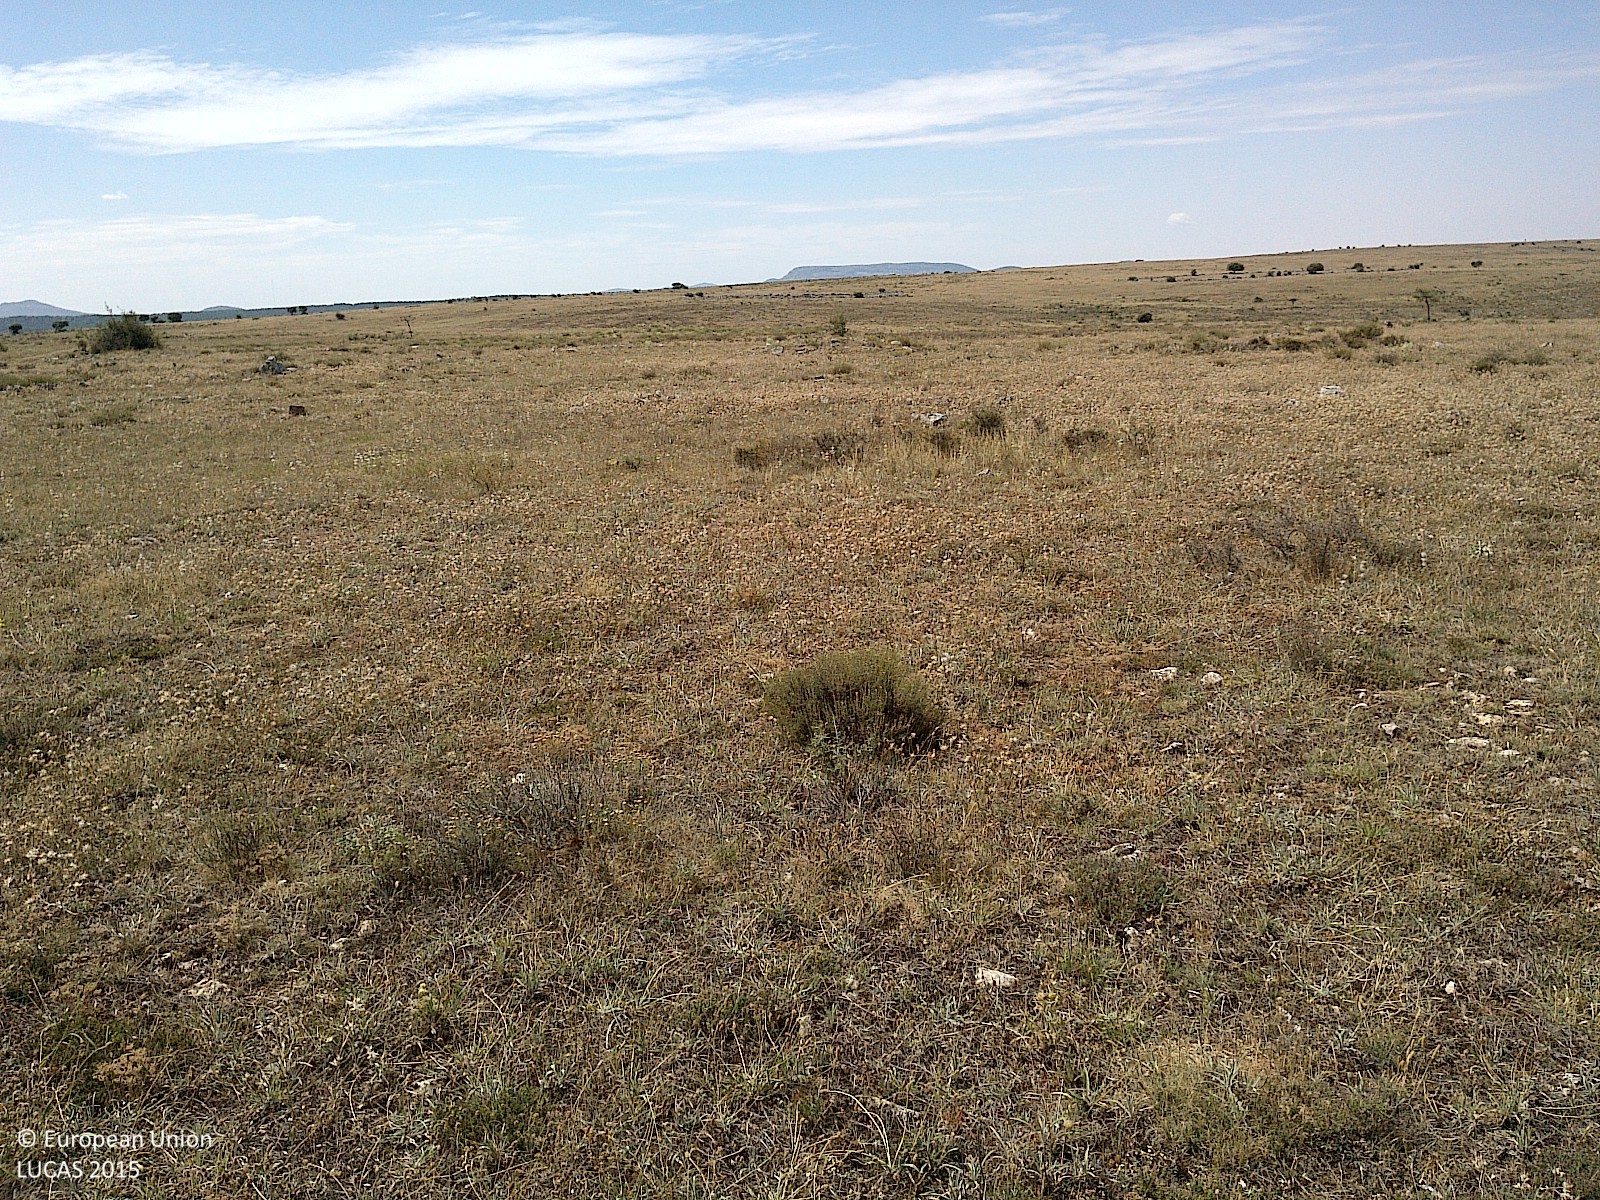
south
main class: Grassland
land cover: Grassland without tree/shrub cover
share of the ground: 50 - 75 %
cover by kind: herbaceous plants 70 %, lichens and mosses 25 %, shrubs 5 %
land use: Agriculture (excluding fallow land and kitchen gardens)
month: July
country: ES
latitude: 41.7291
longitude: -2.0672
